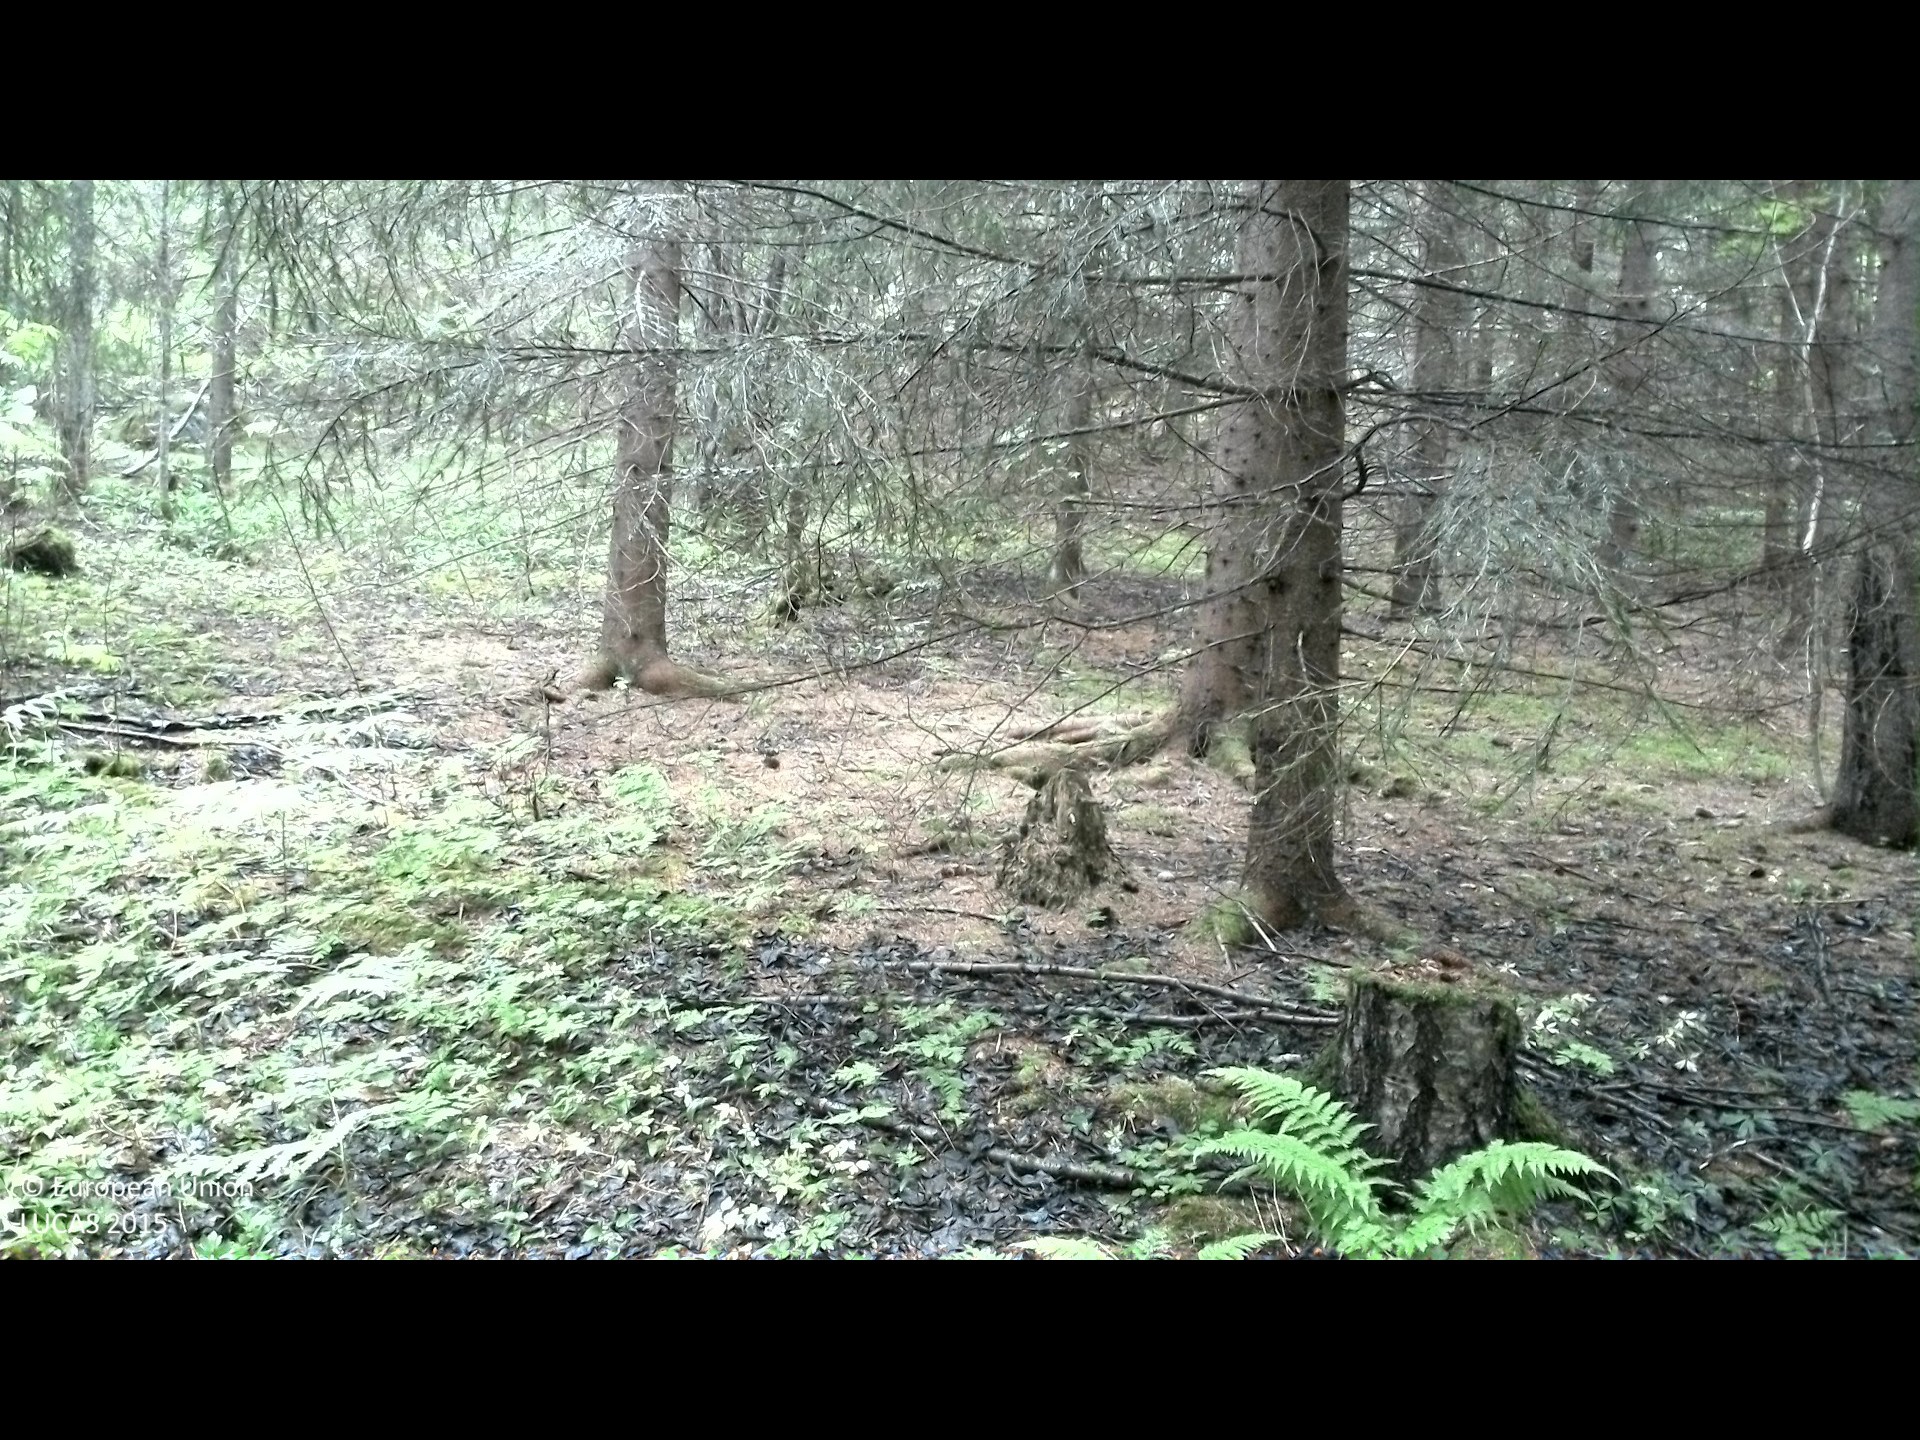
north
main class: Woodland
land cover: Spruce dominated coniferous woodland
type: boreal forest
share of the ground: 50 - 75 %
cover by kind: coniferous forest trees 45 %, herbaceous plants 25 %, lichens and mosses 25 %, broadleaved forest trees 5 %
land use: Forestry
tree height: > 5 m
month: June
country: SE
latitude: 61.9562
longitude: 17.0943
